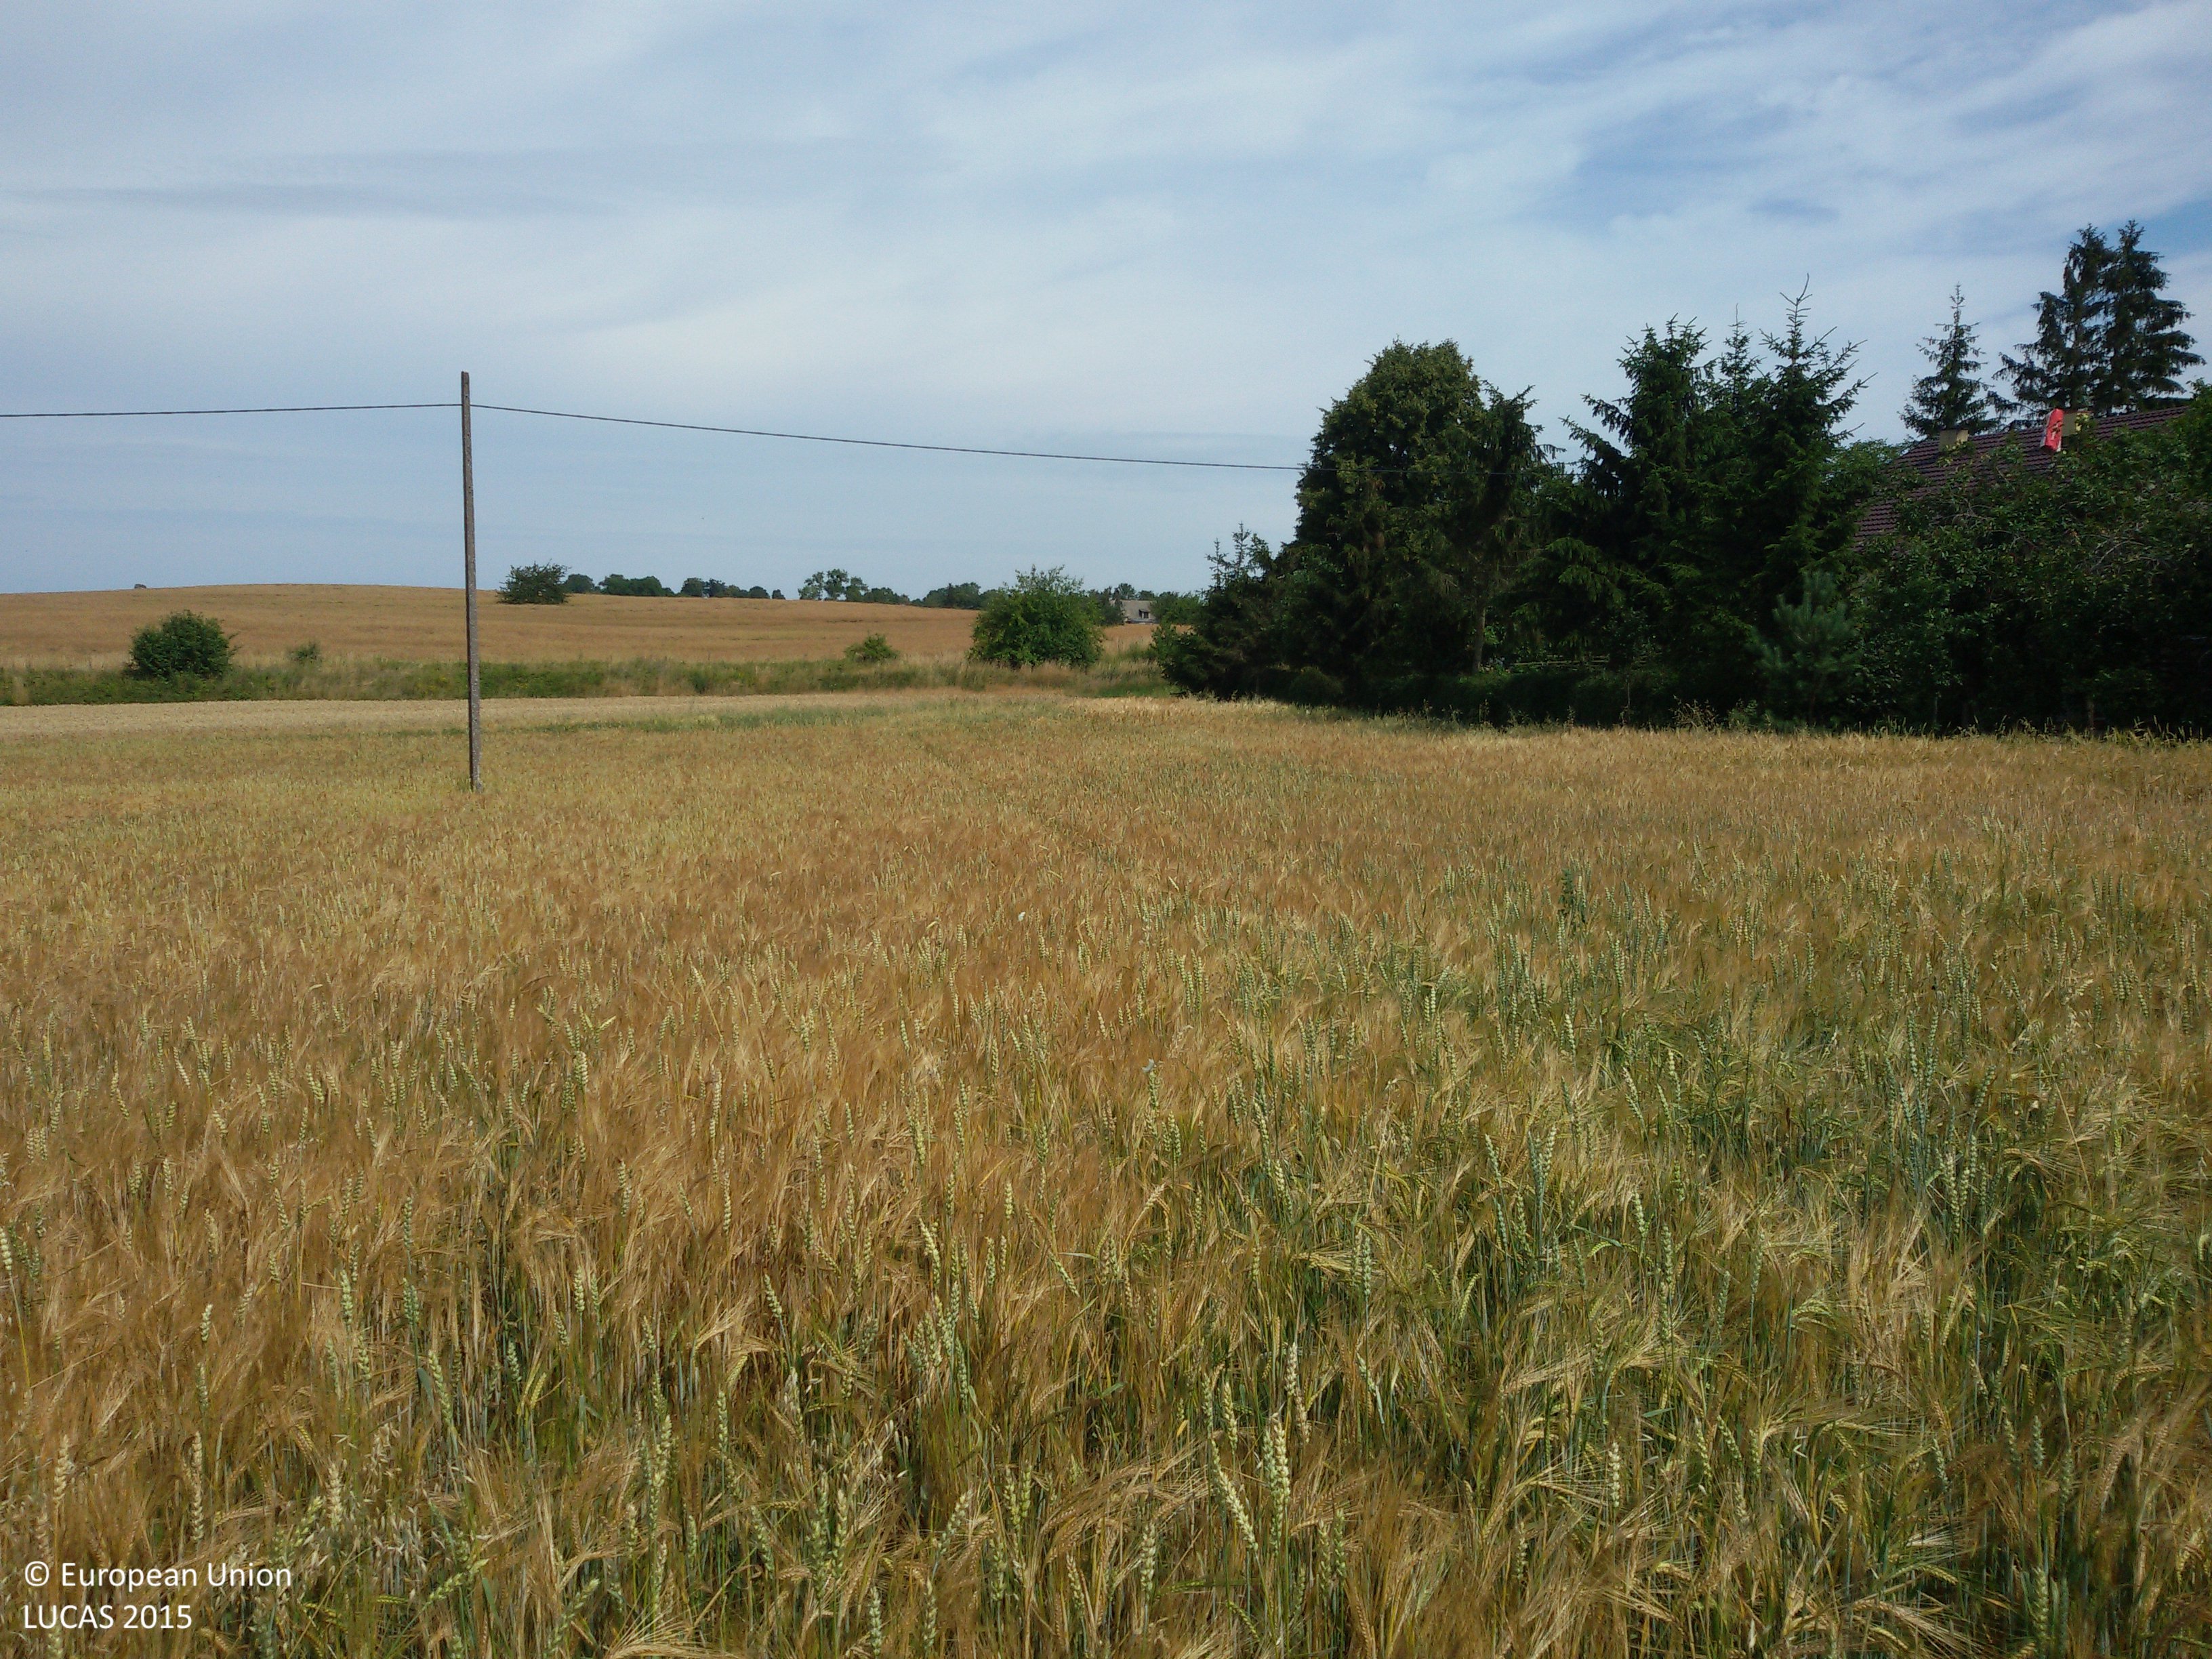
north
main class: Cropland
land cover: Barley
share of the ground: 50 - 75 %
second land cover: Common wheat
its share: 50 - 75 %
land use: Agriculture (excluding fallow land and kitchen gardens)
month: July
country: PL
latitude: 53.4433
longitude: 17.7366
